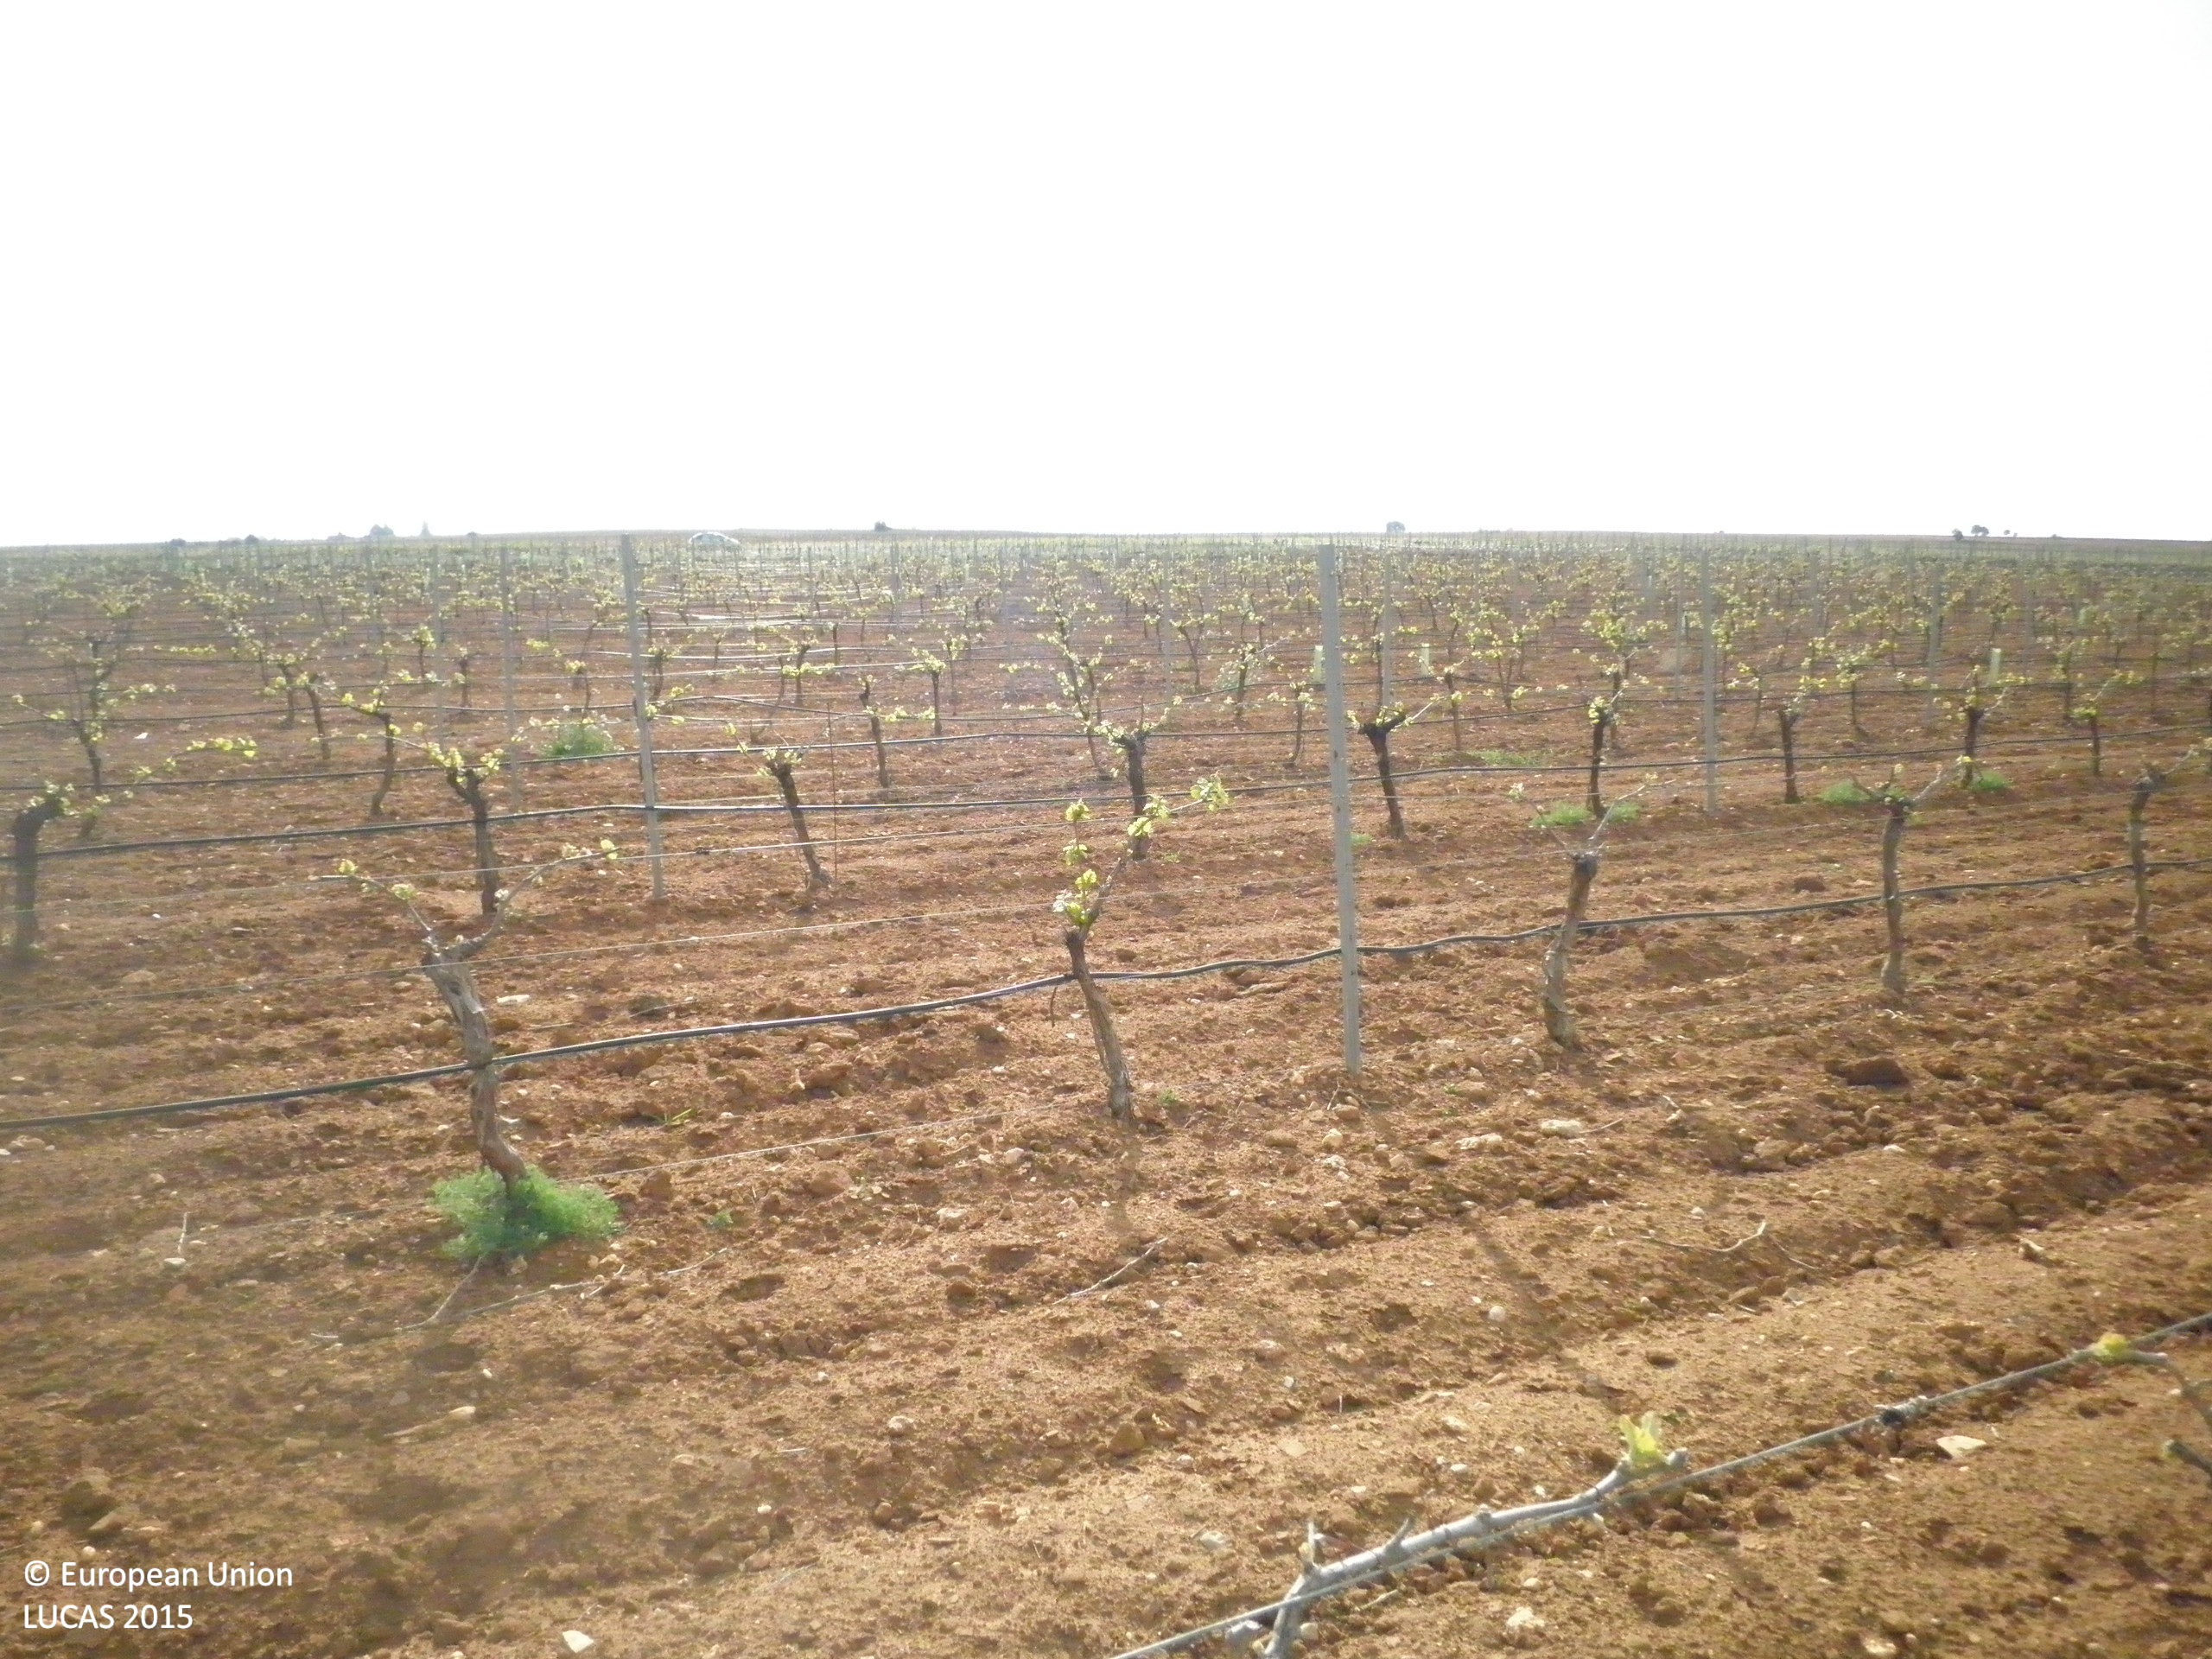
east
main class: Cropland
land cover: Vineyards
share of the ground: < 10 %
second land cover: Other bare soil
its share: > 75 %
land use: Agriculture (excluding fallow land and kitchen gardens)
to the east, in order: Vineyards; Other bare soil; Grass margins; Tracks; Spontaneously vegetated surfaces; Vineyards
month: April
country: ES
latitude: 39.3742
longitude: -2.7703
